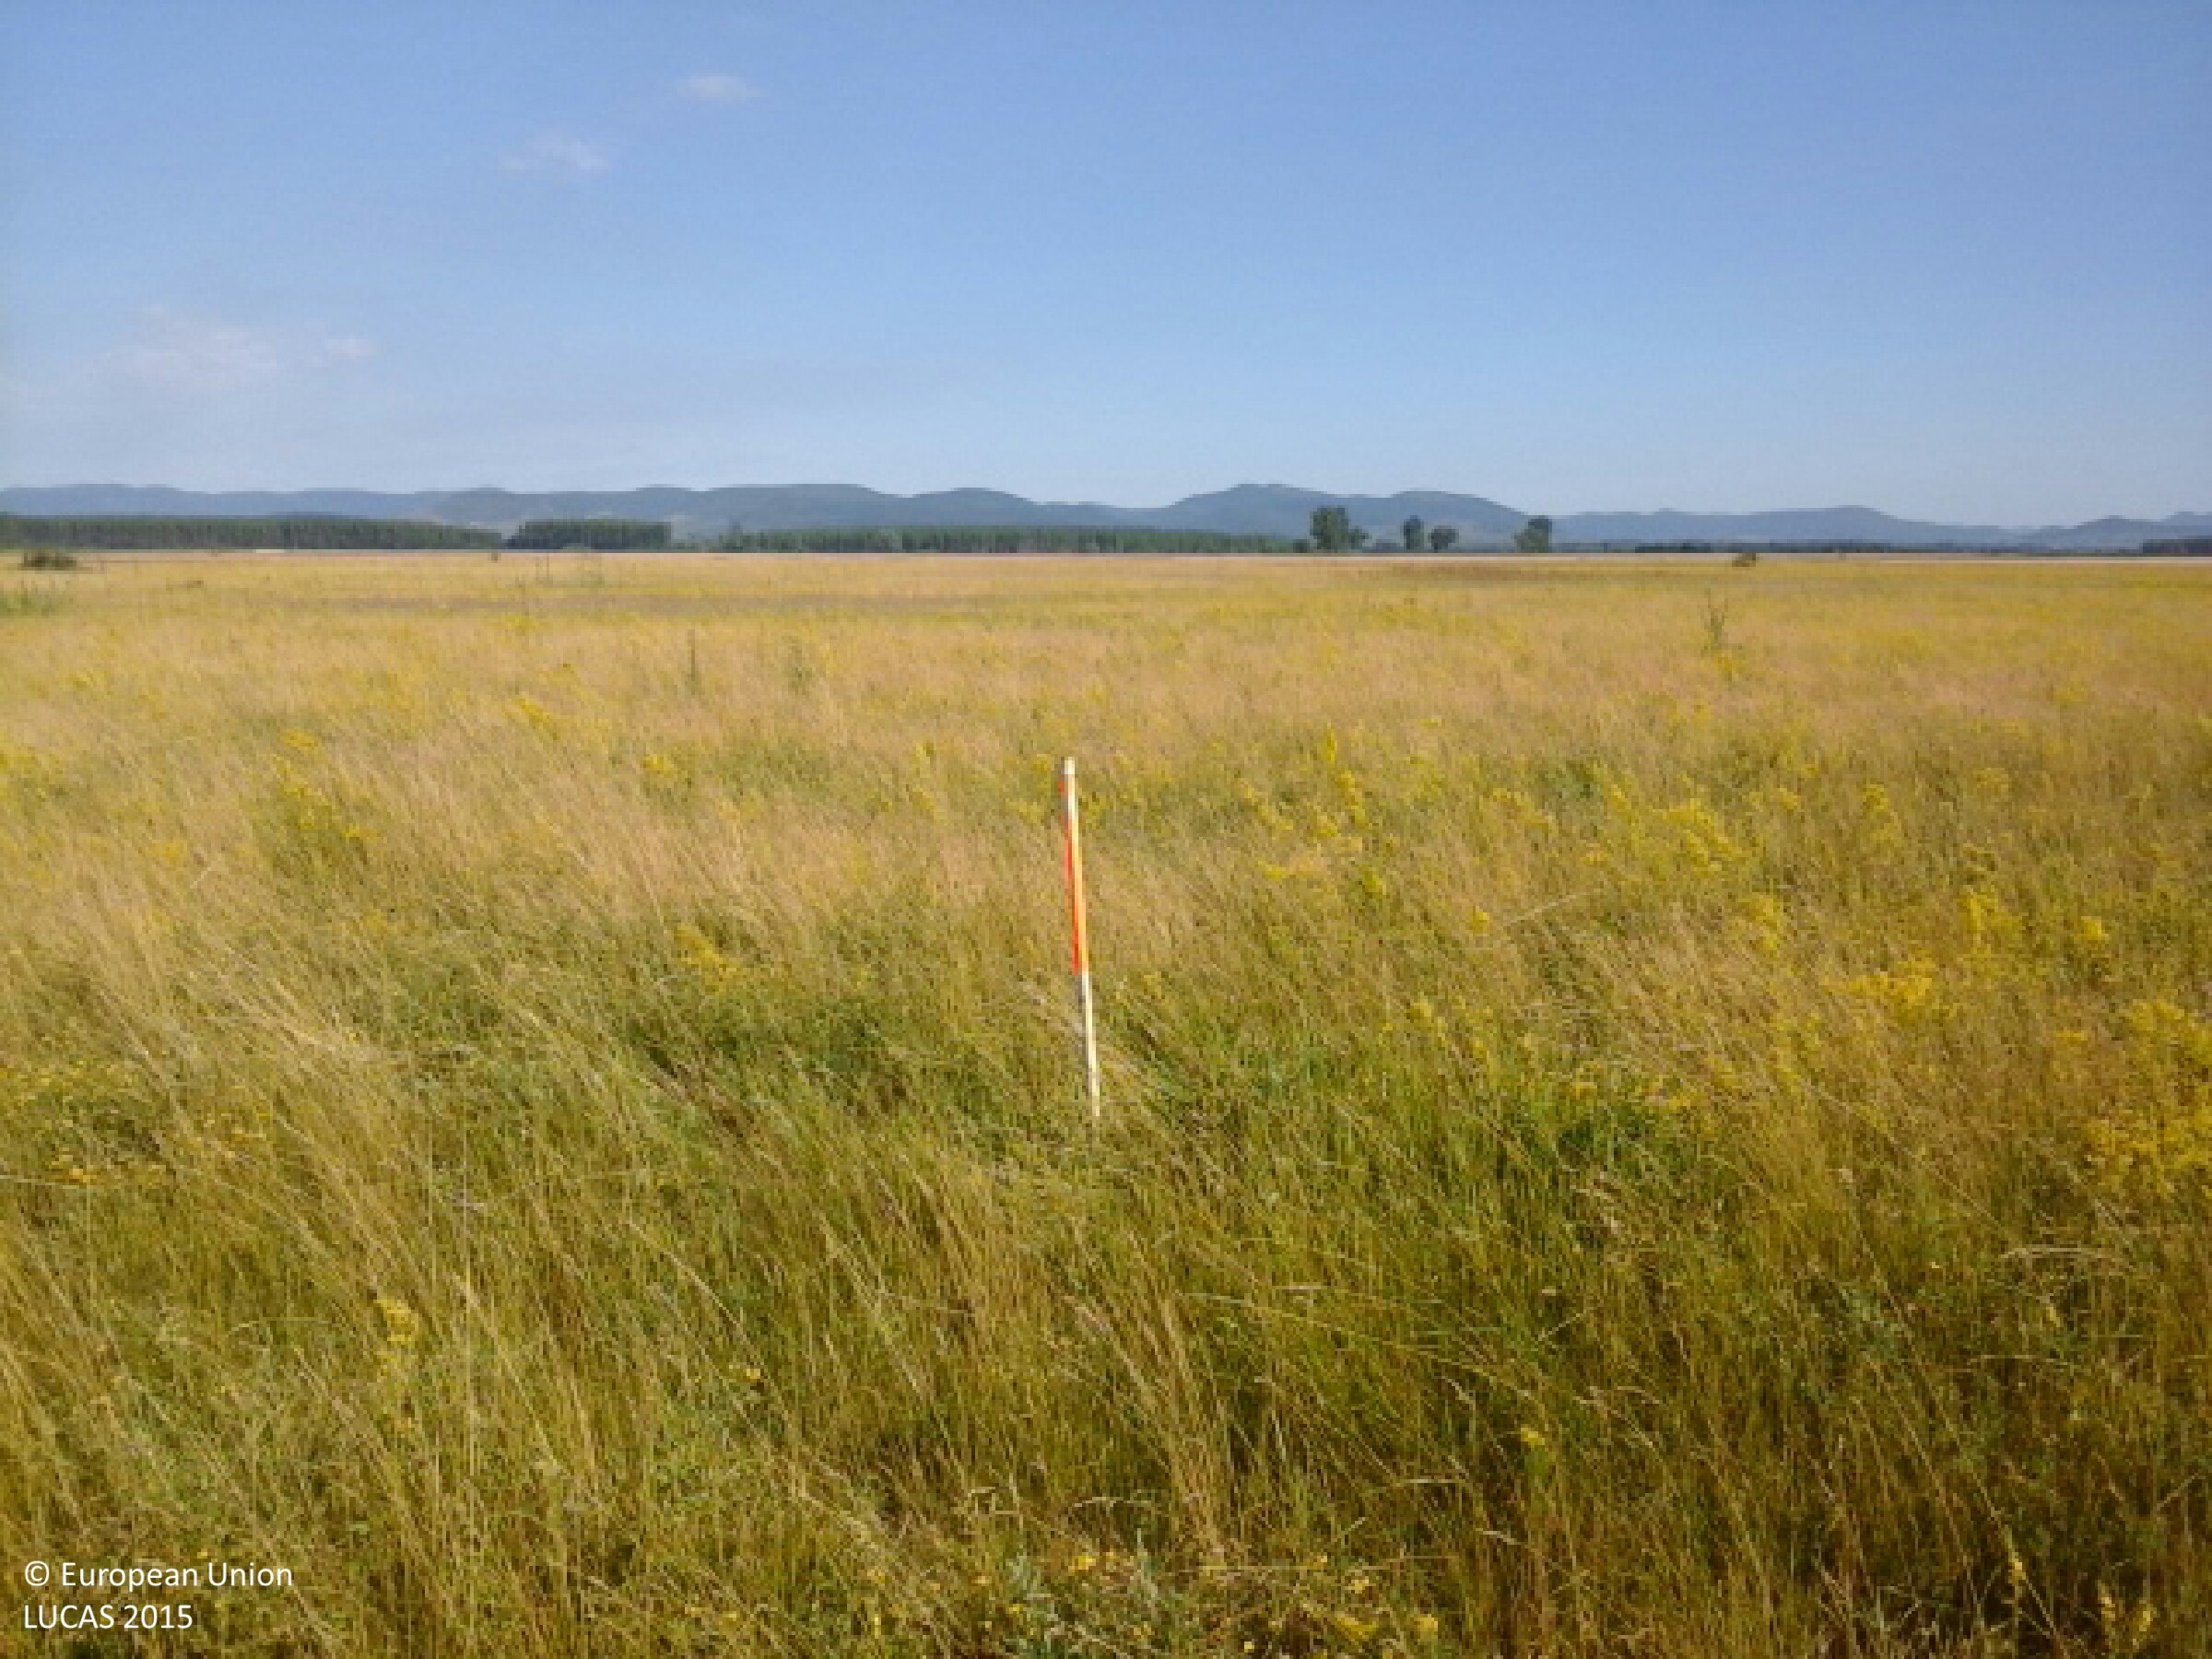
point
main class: Grassland
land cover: Grassland without tree/shrub cover
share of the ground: > 75 %
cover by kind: herbaceous plants 100 %
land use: Semi-natural and natural areas not in use
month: July
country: HU
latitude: 48.2313
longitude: 21.5575
